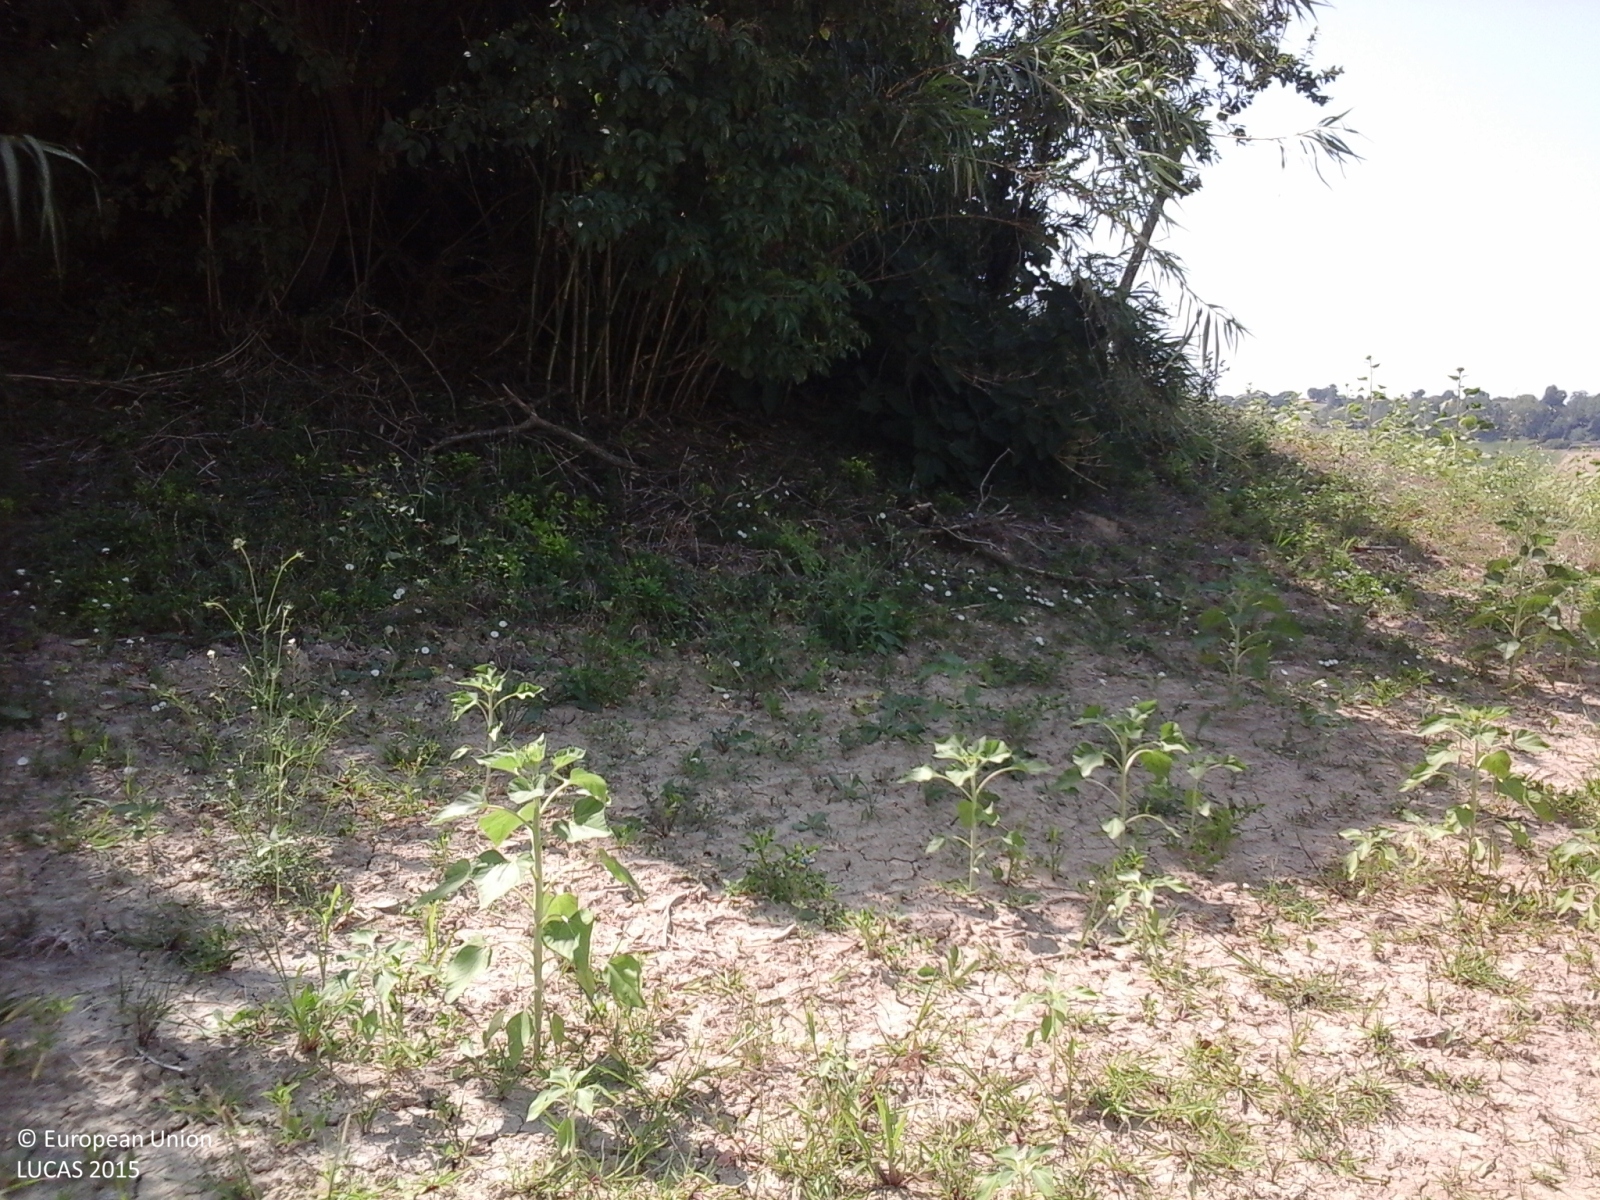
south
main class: Cropland
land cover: Sunflower
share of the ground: 25 - 50 %
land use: Agriculture (excluding fallow land and kitchen gardens)
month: July
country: IT
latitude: 43.3900
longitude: 13.4603
